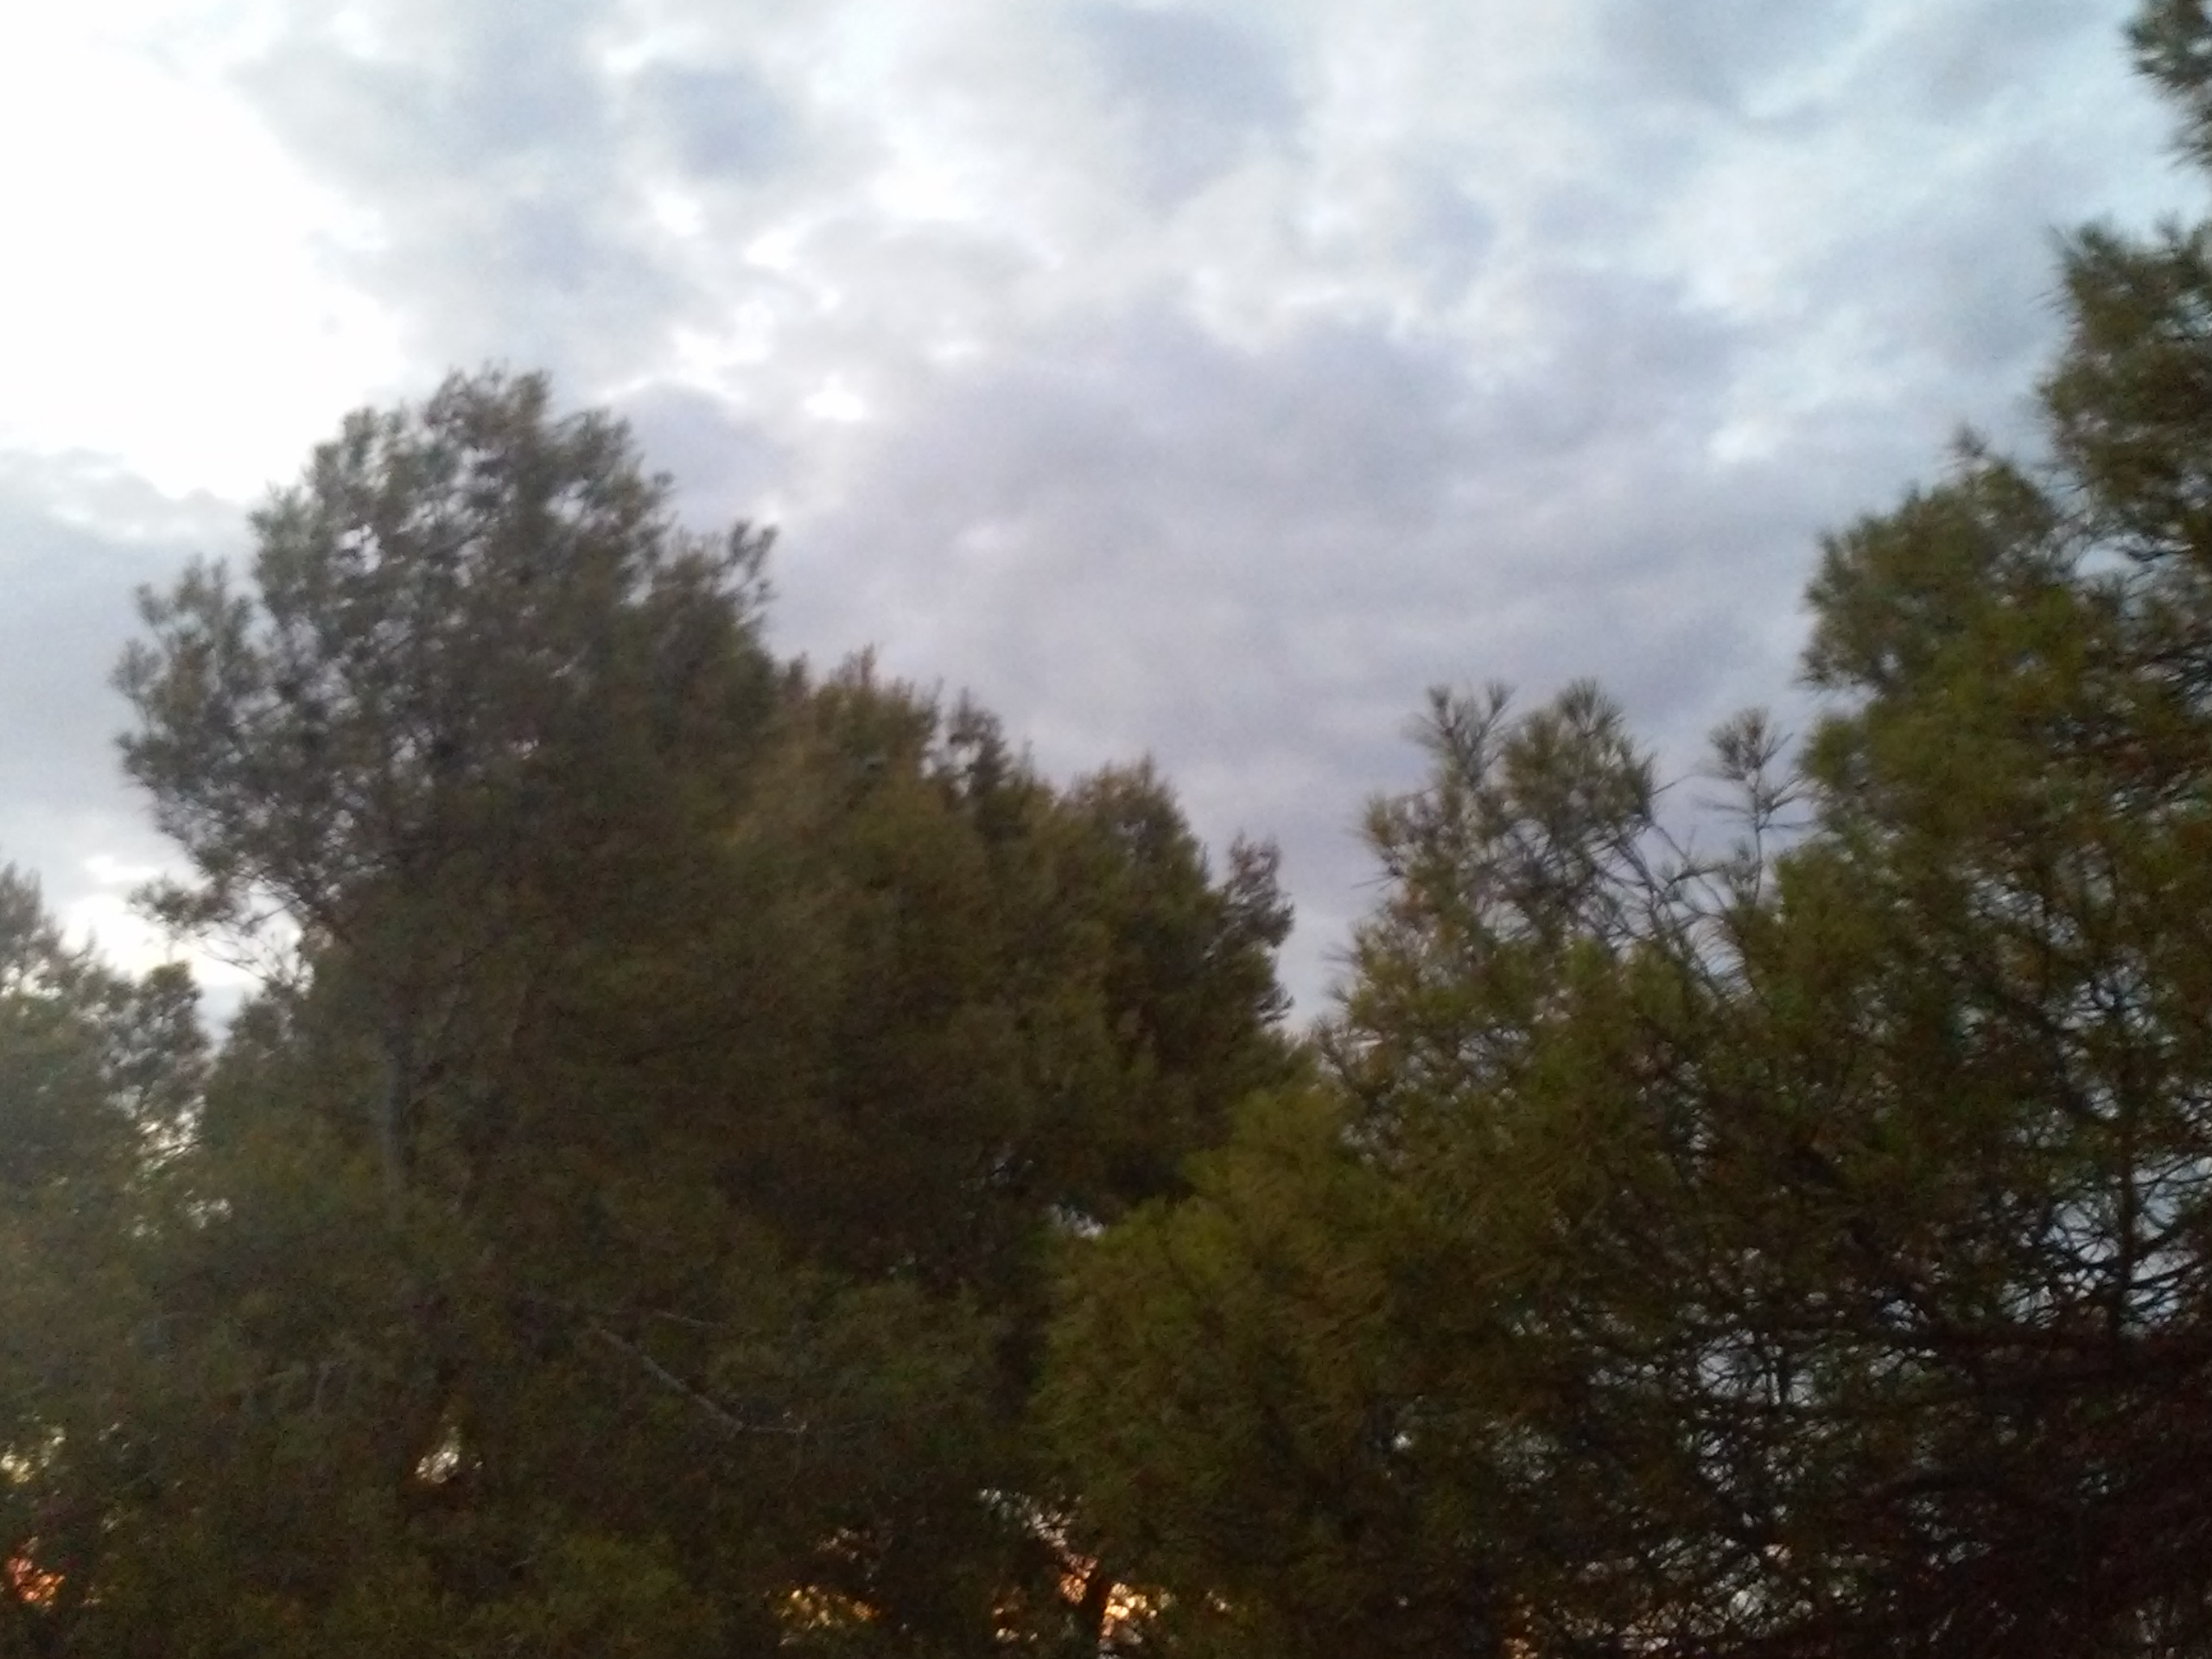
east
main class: Woodland
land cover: Pine dominated coniferous woodland
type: coniferous forest of the mediterranean region
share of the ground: 10 - 25 %
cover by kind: consolidated bare surface 30 %, shrubs 25 %, coniferous forest trees 20 %, herbaceous plants 20 %, broadleaved forest trees 5 %
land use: Semi-natural and natural areas not in use
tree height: < 5 m
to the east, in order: Pine dominated coniferous woodland; Paved roads, cycling and walking lanes; Olive groves; Dry stone walls; Olive groves; Dry stone walls; Olive groves; Dry stone walls; Olive groves; Dry stone walls; Olive groves; Dry stone walls; Olive groves; Dry stone walls; Olive groves; Artificial constructions in urban areas
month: August
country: ES
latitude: 41.4136
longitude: 0.7660
